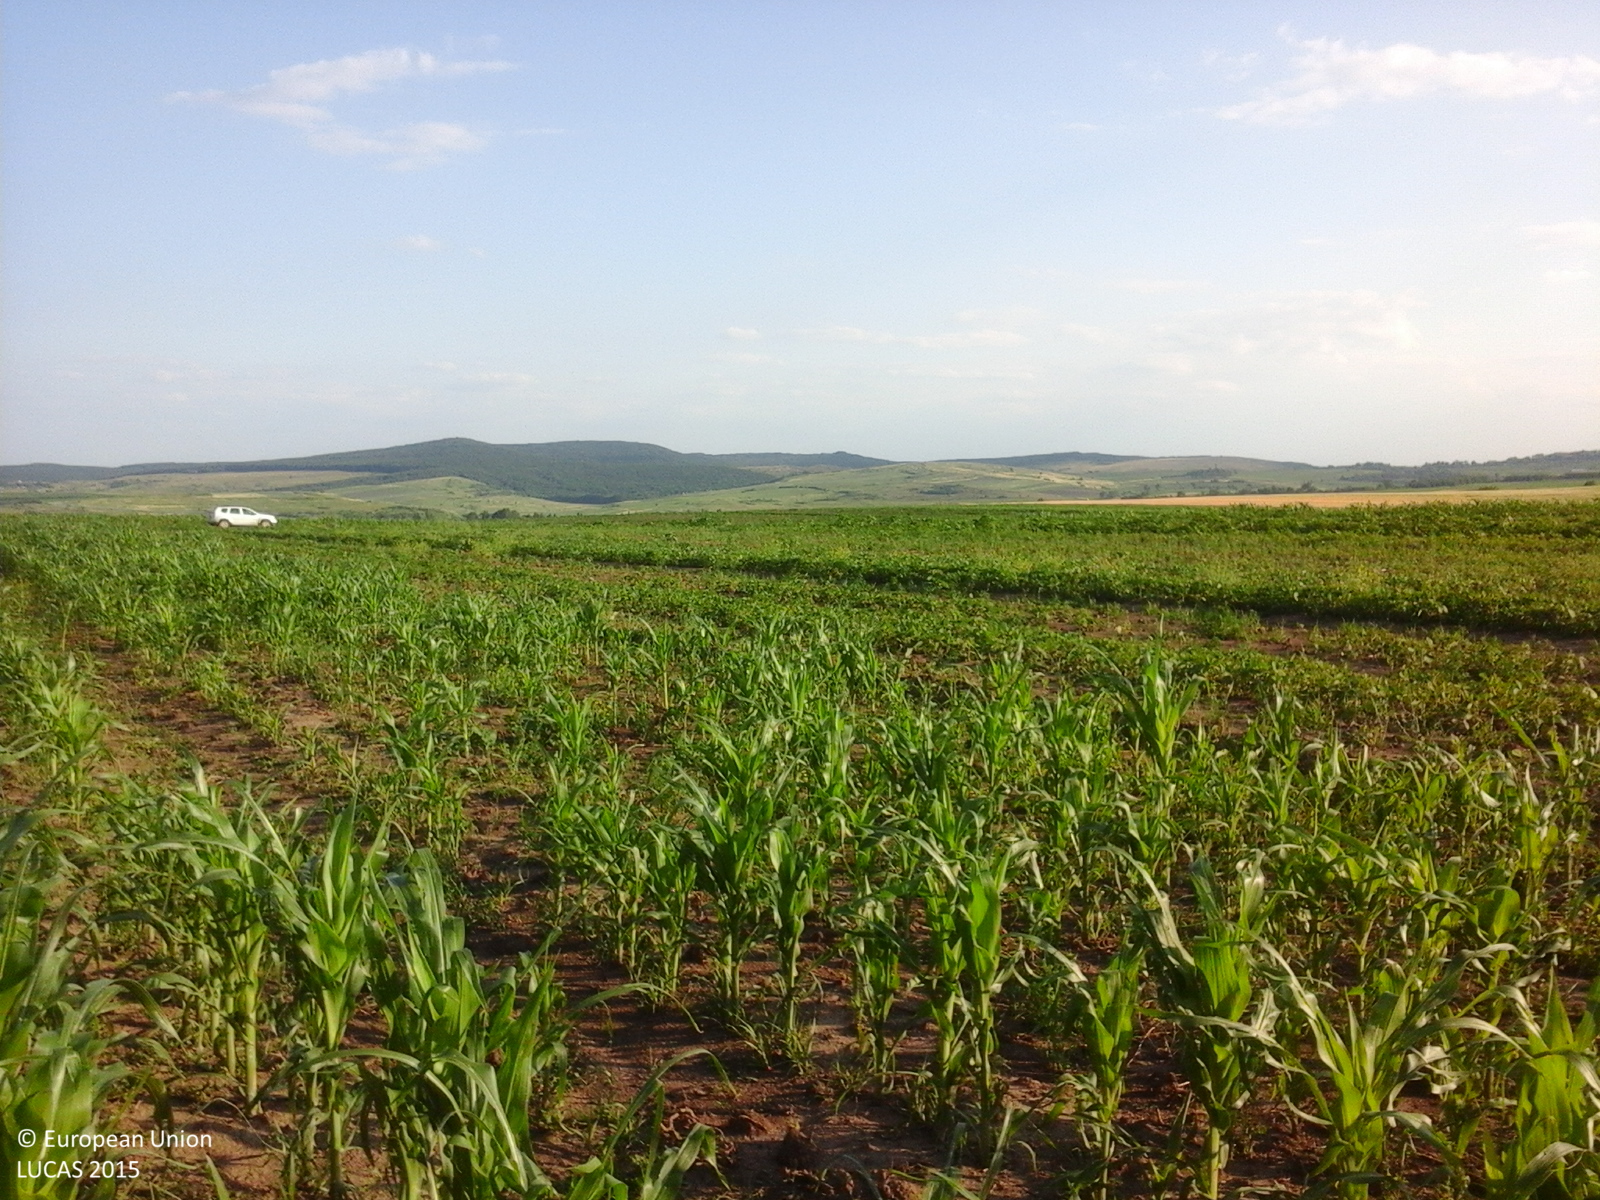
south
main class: Cropland
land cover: Maize
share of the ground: 50 - 75 %
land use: Agriculture (excluding fallow land and kitchen gardens)
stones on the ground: < 10 %
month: June
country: RO
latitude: 47.8344
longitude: 26.4833
